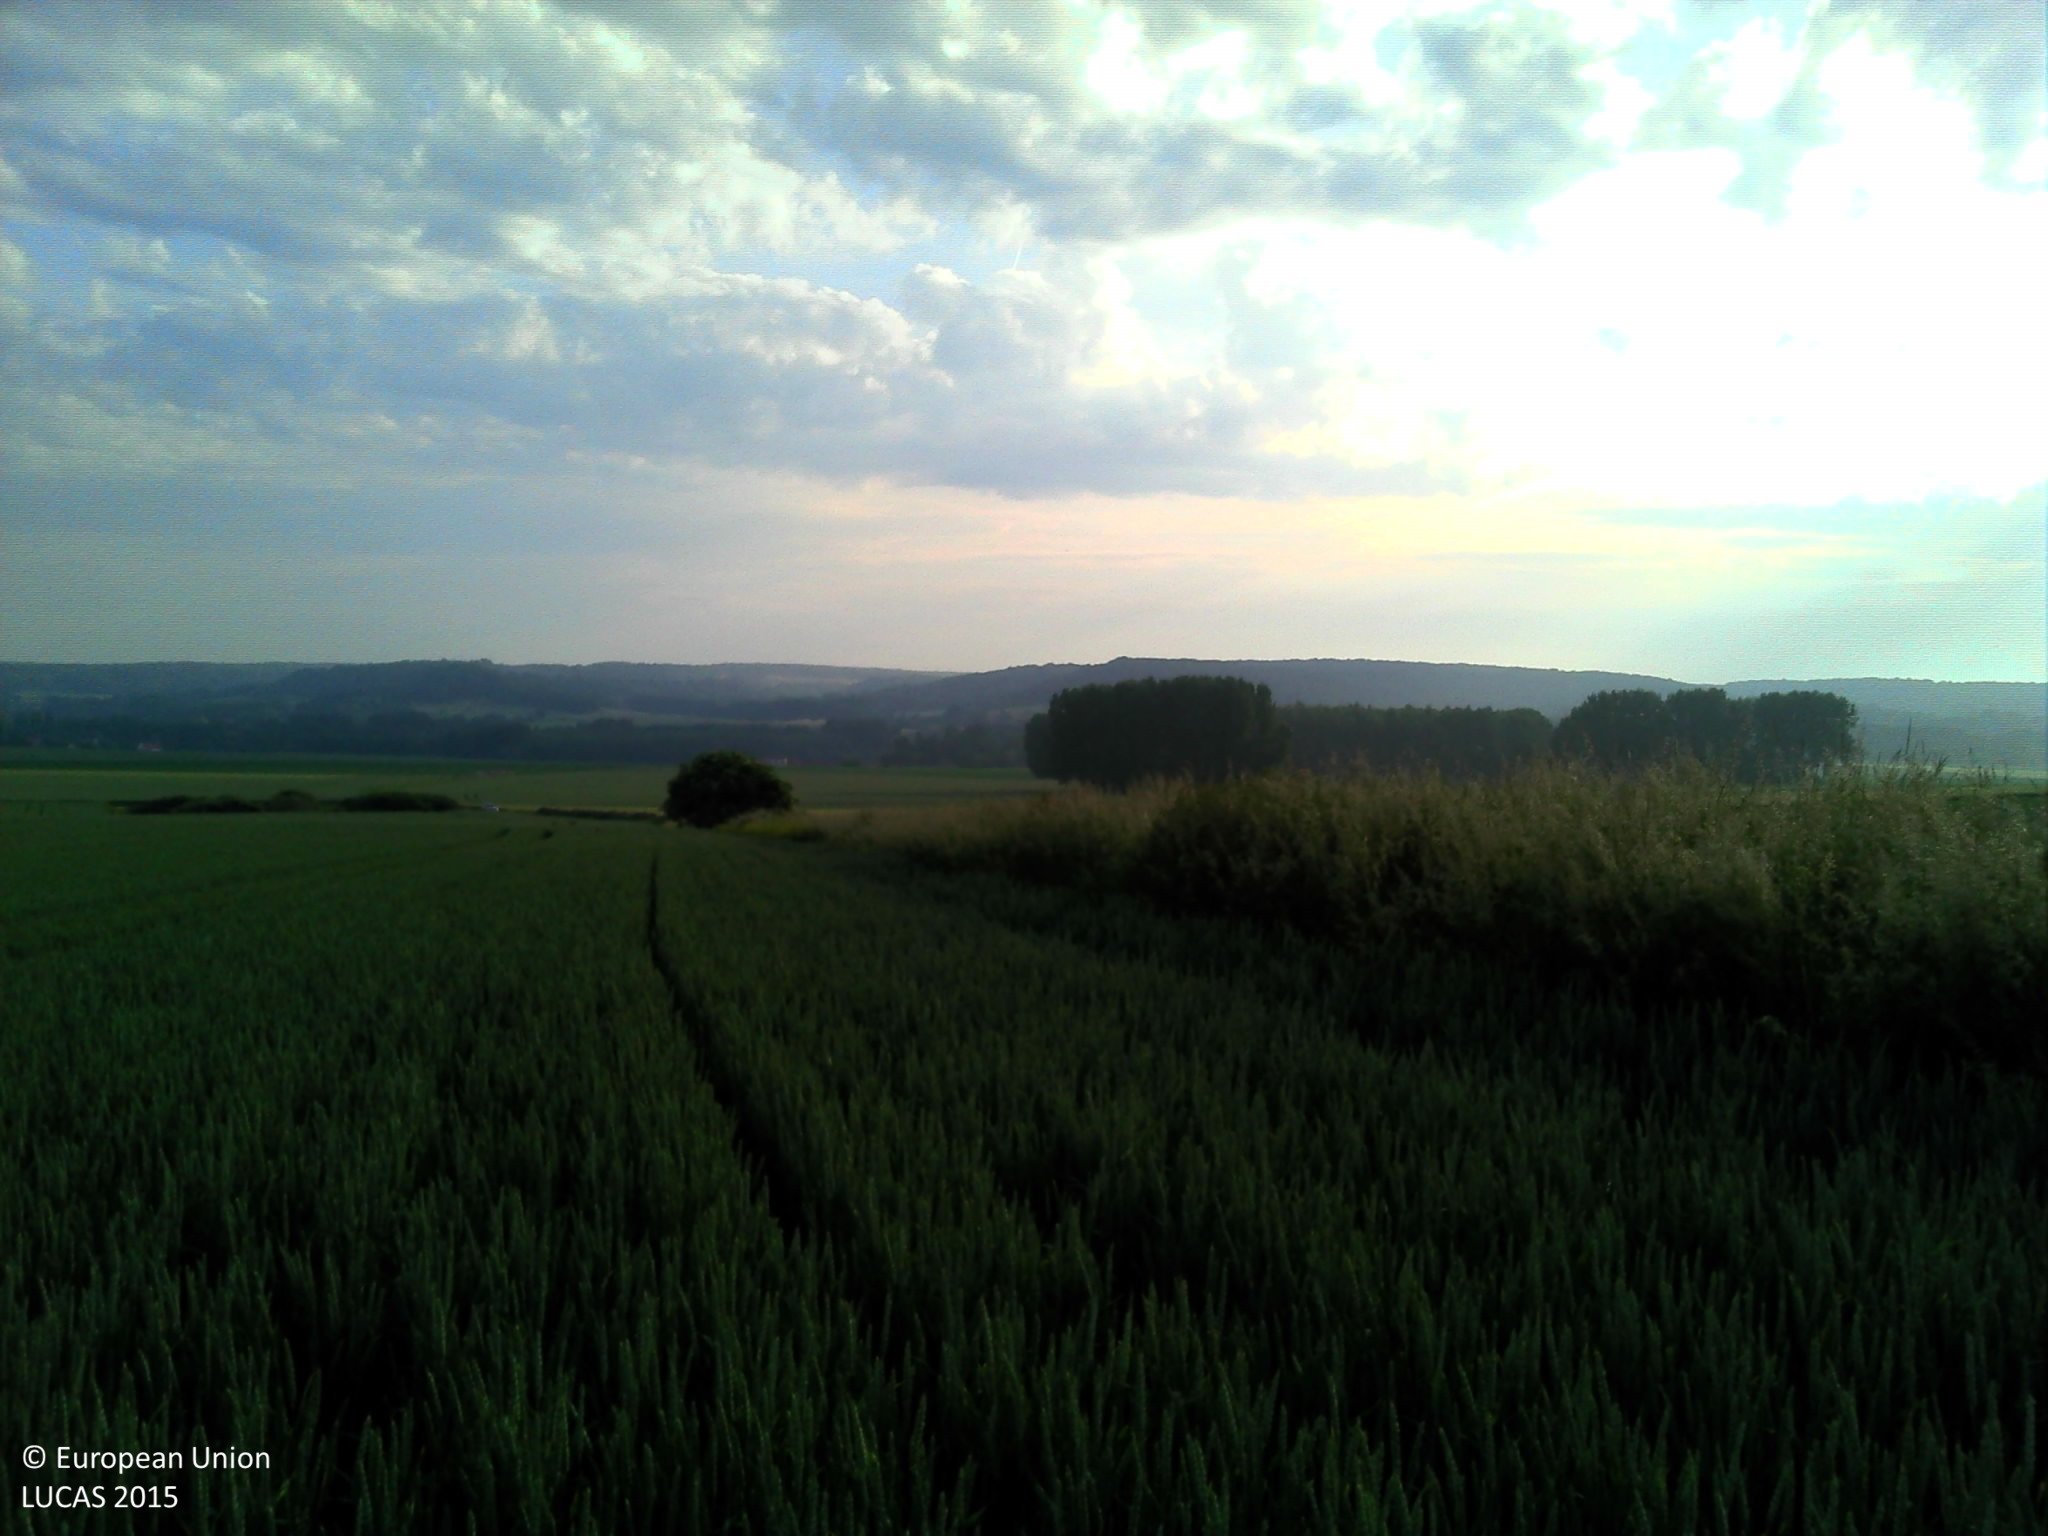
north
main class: Cropland
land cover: Common wheat
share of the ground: > 75 %
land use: Agriculture (excluding fallow land and kitchen gardens)
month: June
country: FR
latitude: 49.4886
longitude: 2.8250
